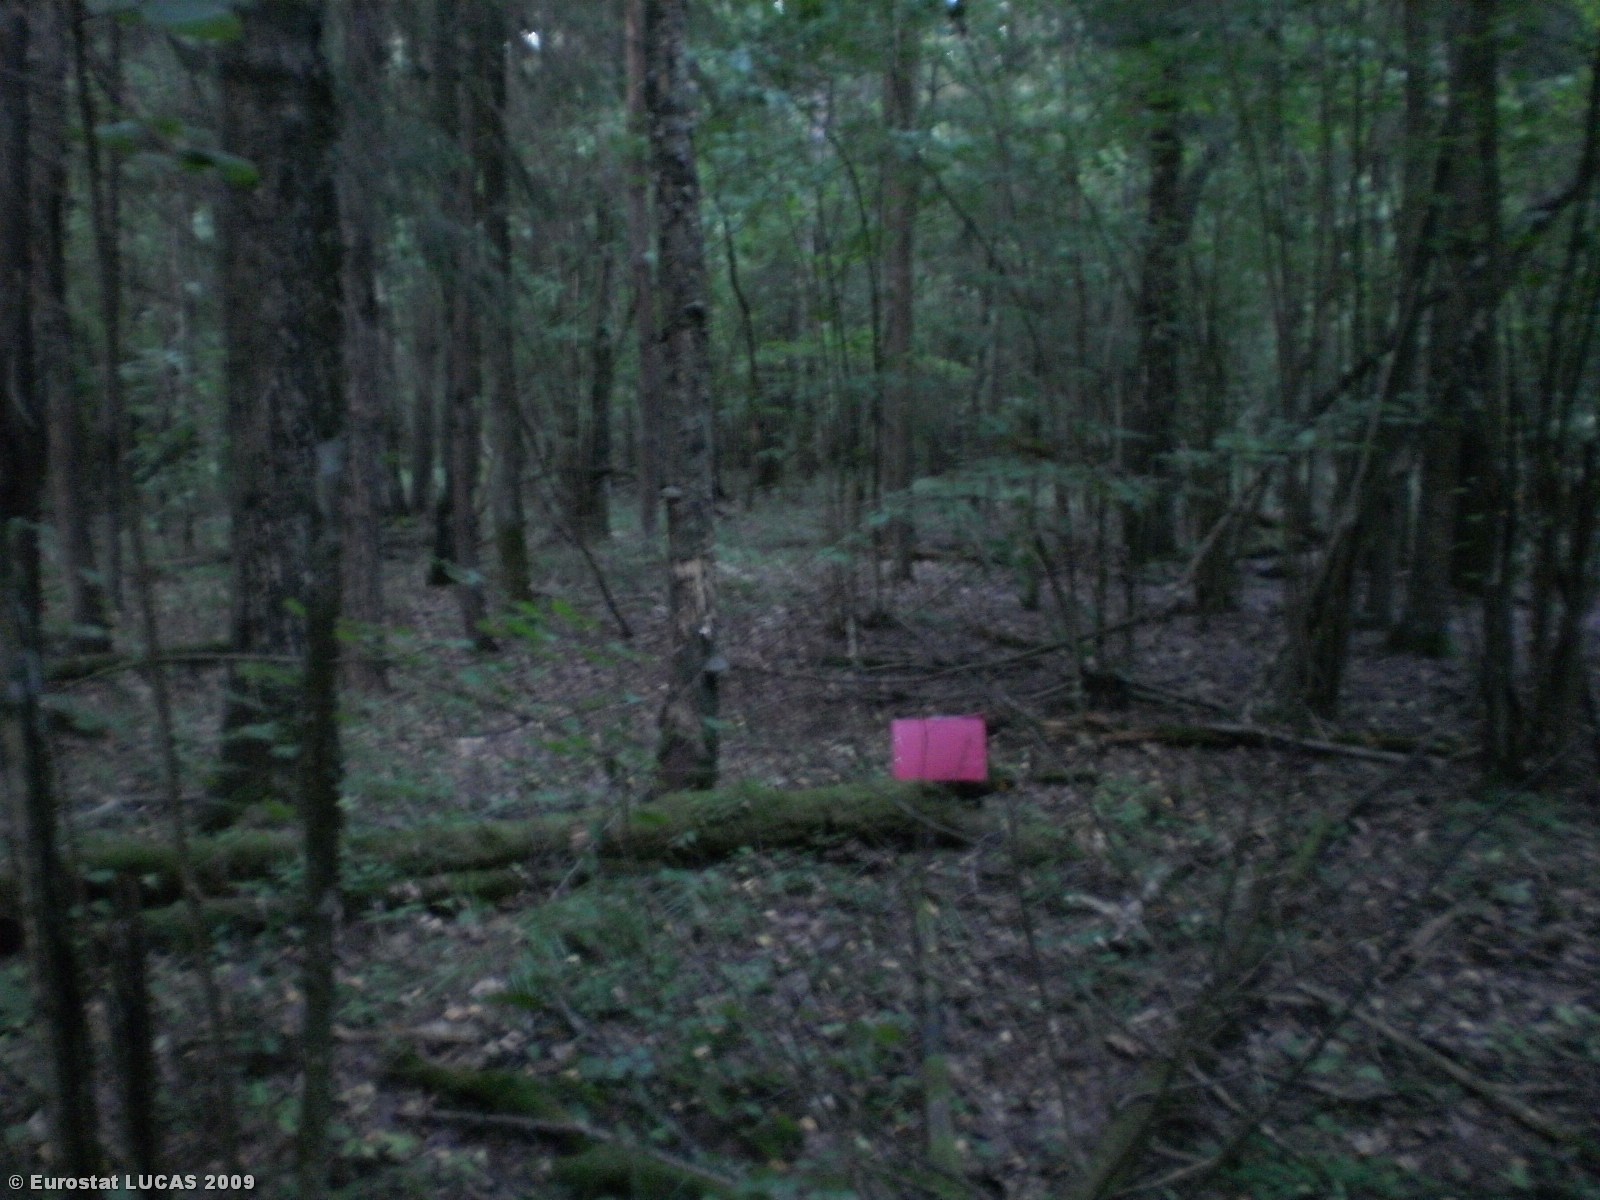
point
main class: Woodland
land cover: Mixed woodland
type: hemiboreal forest and nemoral coniferous forest and mixed broadleaved-coniferous forest
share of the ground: > 75 %
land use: Forestry
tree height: > 5 m
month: August
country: LT
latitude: 54.8235
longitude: 24.5314
